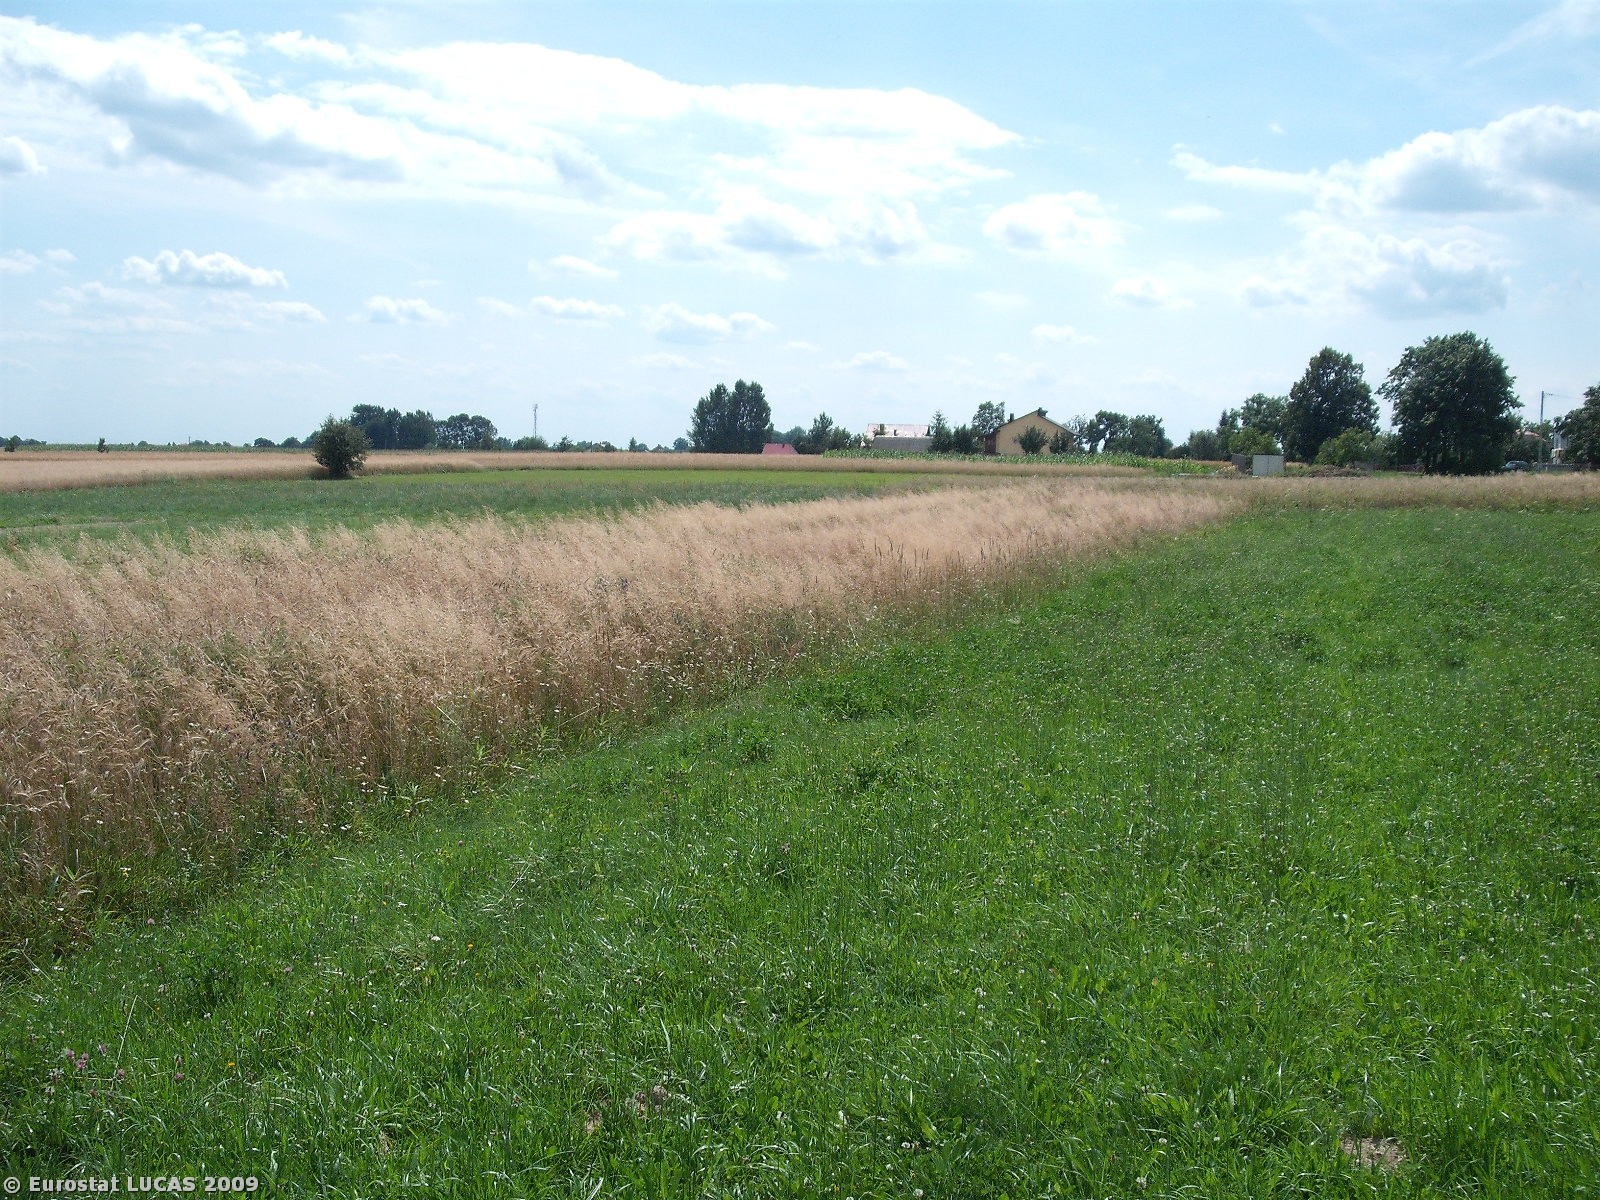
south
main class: Grassland
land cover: Grassland without tree/shrub cover
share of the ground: > 75 %
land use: Agriculture (excluding fallow land and kitchen gardens)
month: July
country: PL
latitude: 50.6795
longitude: 21.2417
